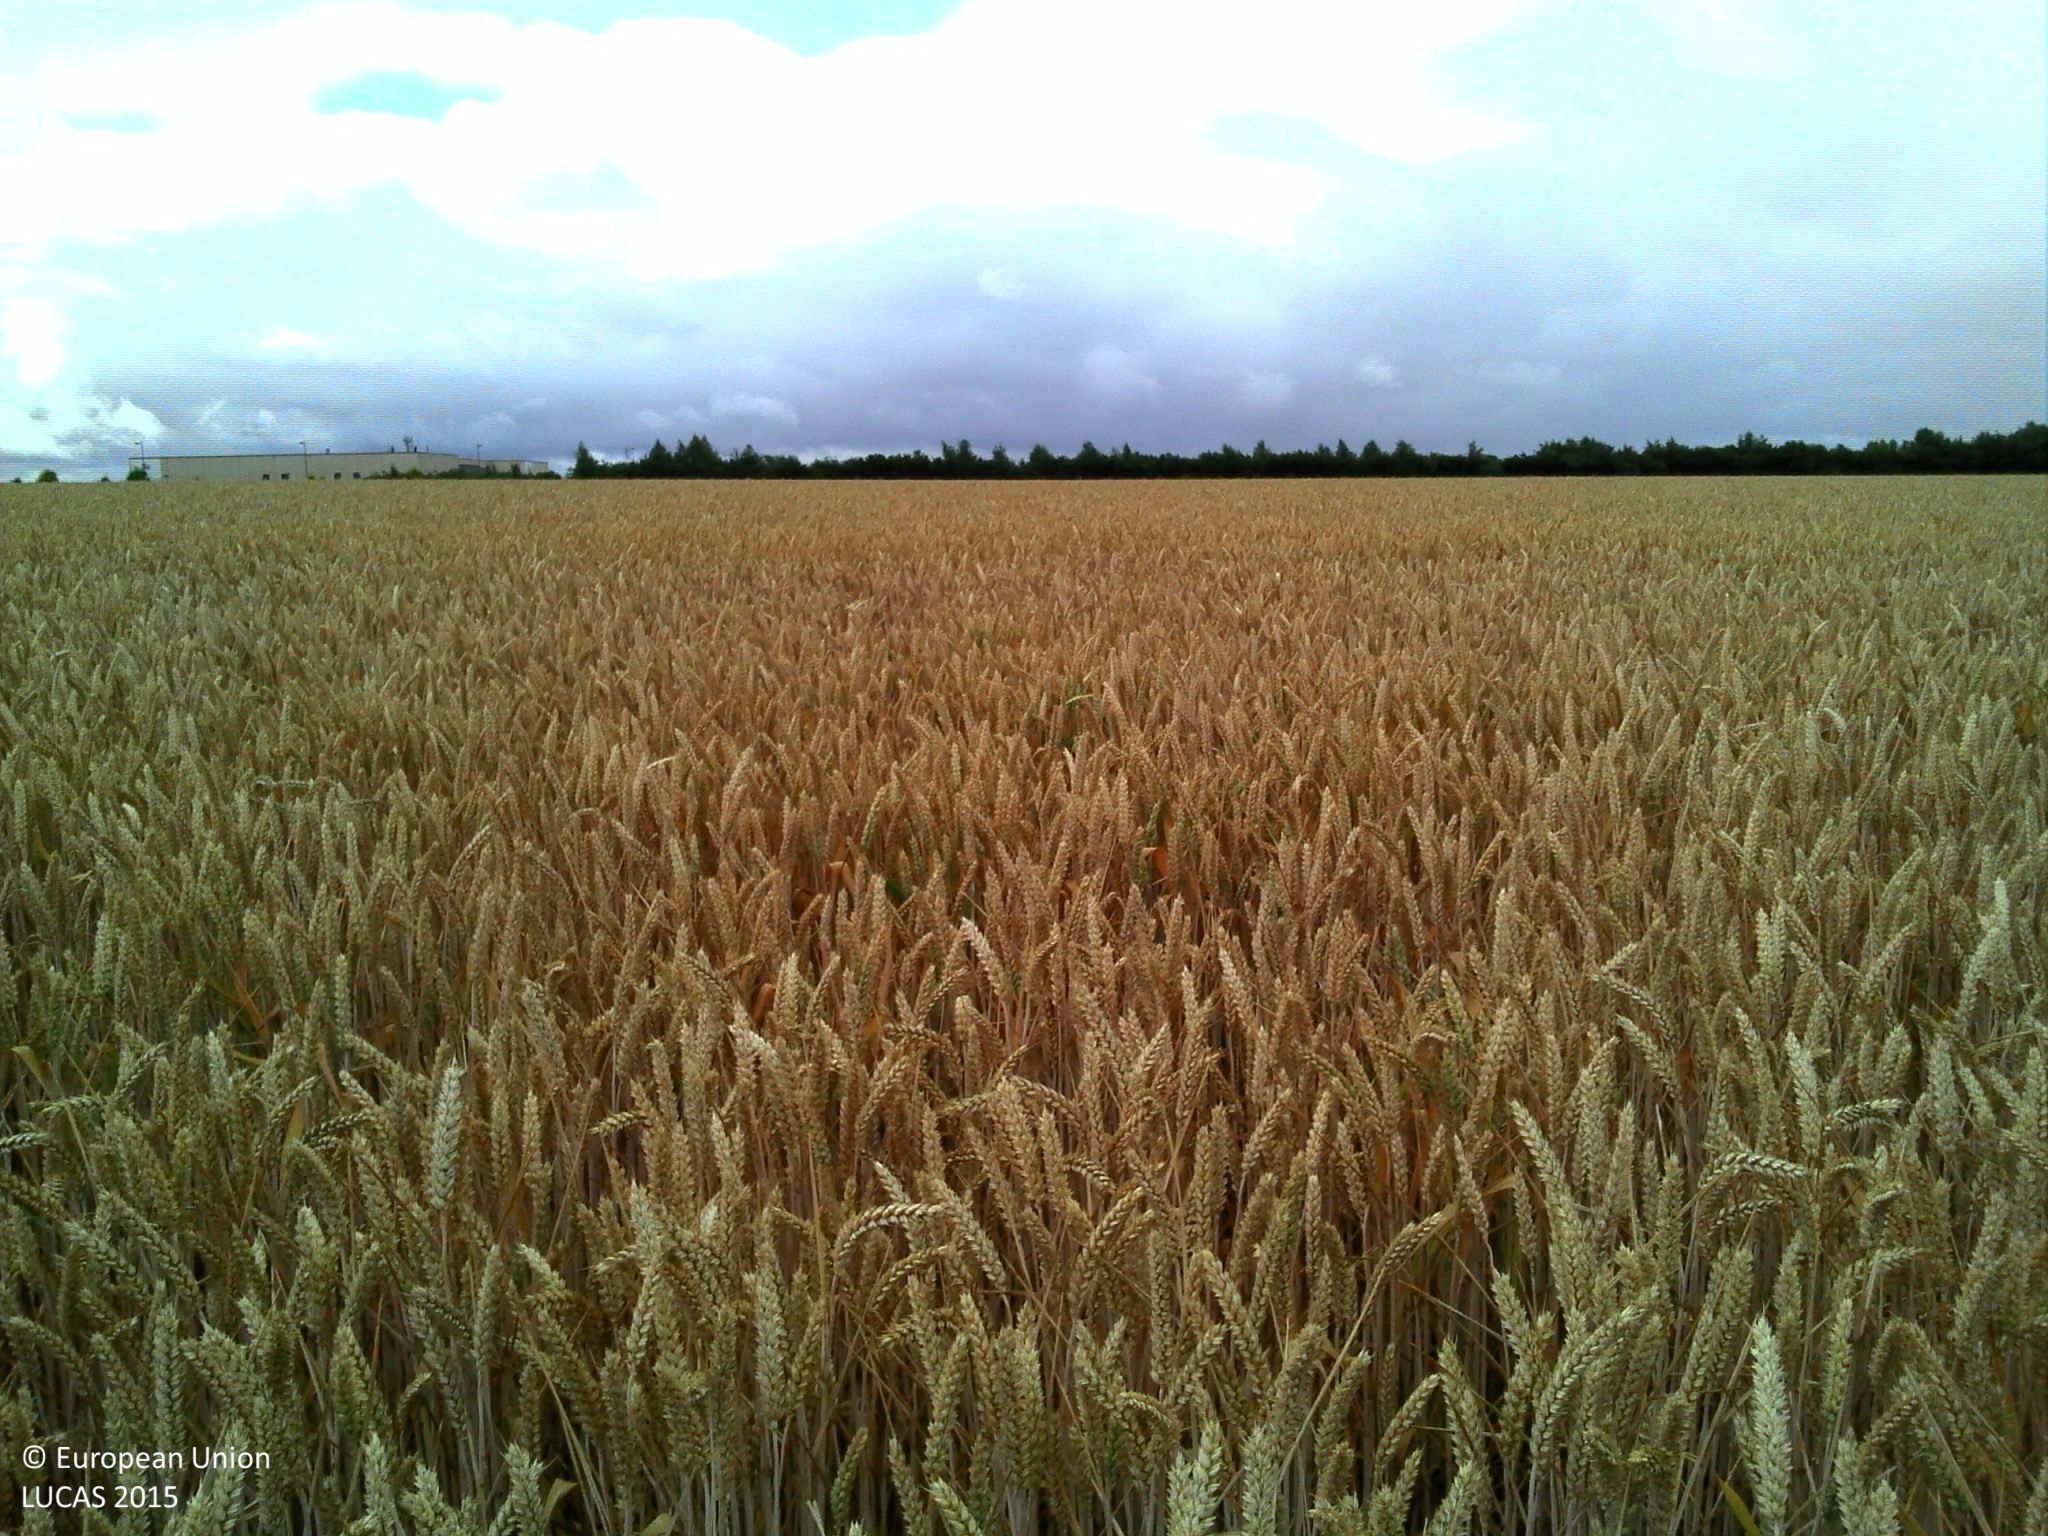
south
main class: Cropland
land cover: Common wheat
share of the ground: > 75 %
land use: Agriculture (excluding fallow land and kitchen gardens)
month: July
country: FR
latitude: 50.1260
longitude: 3.2071
